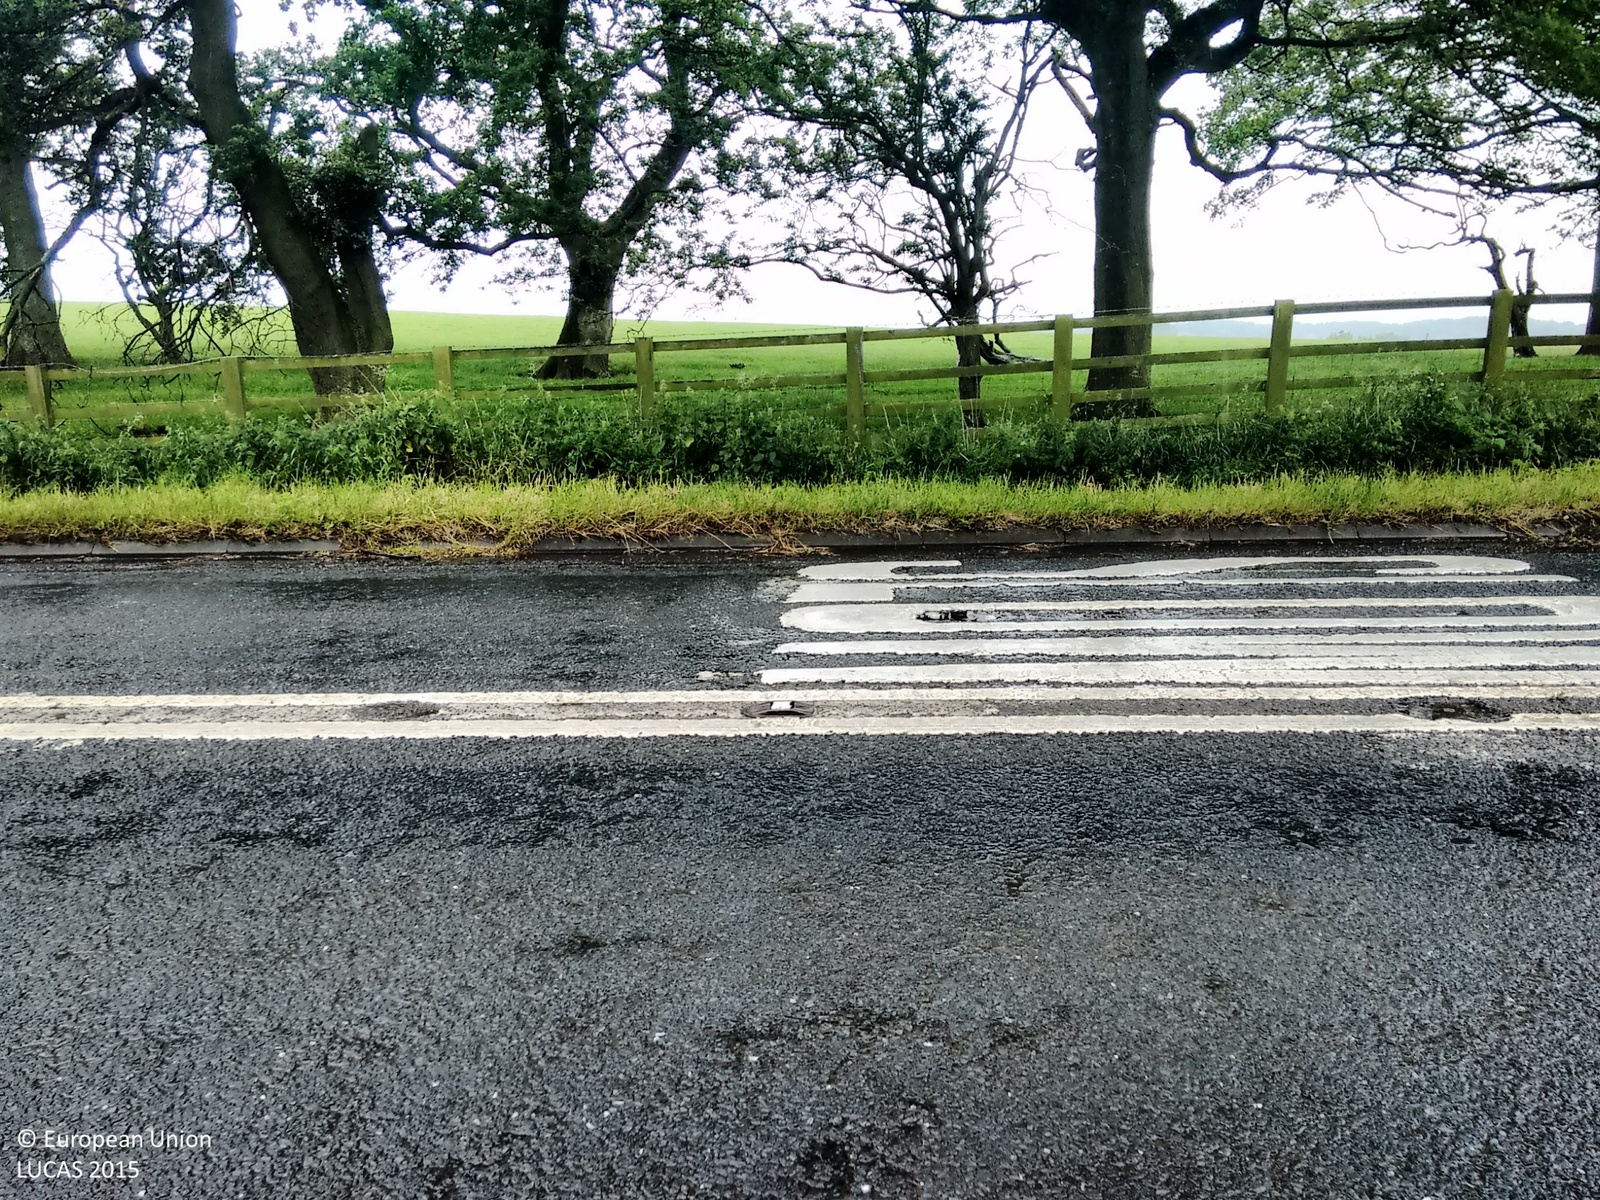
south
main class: Woodland
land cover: Broadleaved woodland
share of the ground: > 75 %
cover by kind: broadleaved forest trees 45 %, herbaceous plants 15 %
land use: Semi-natural and natural areas not in use
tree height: > 5 m
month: July
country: GB
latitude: 54.5452
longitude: -1.8482
